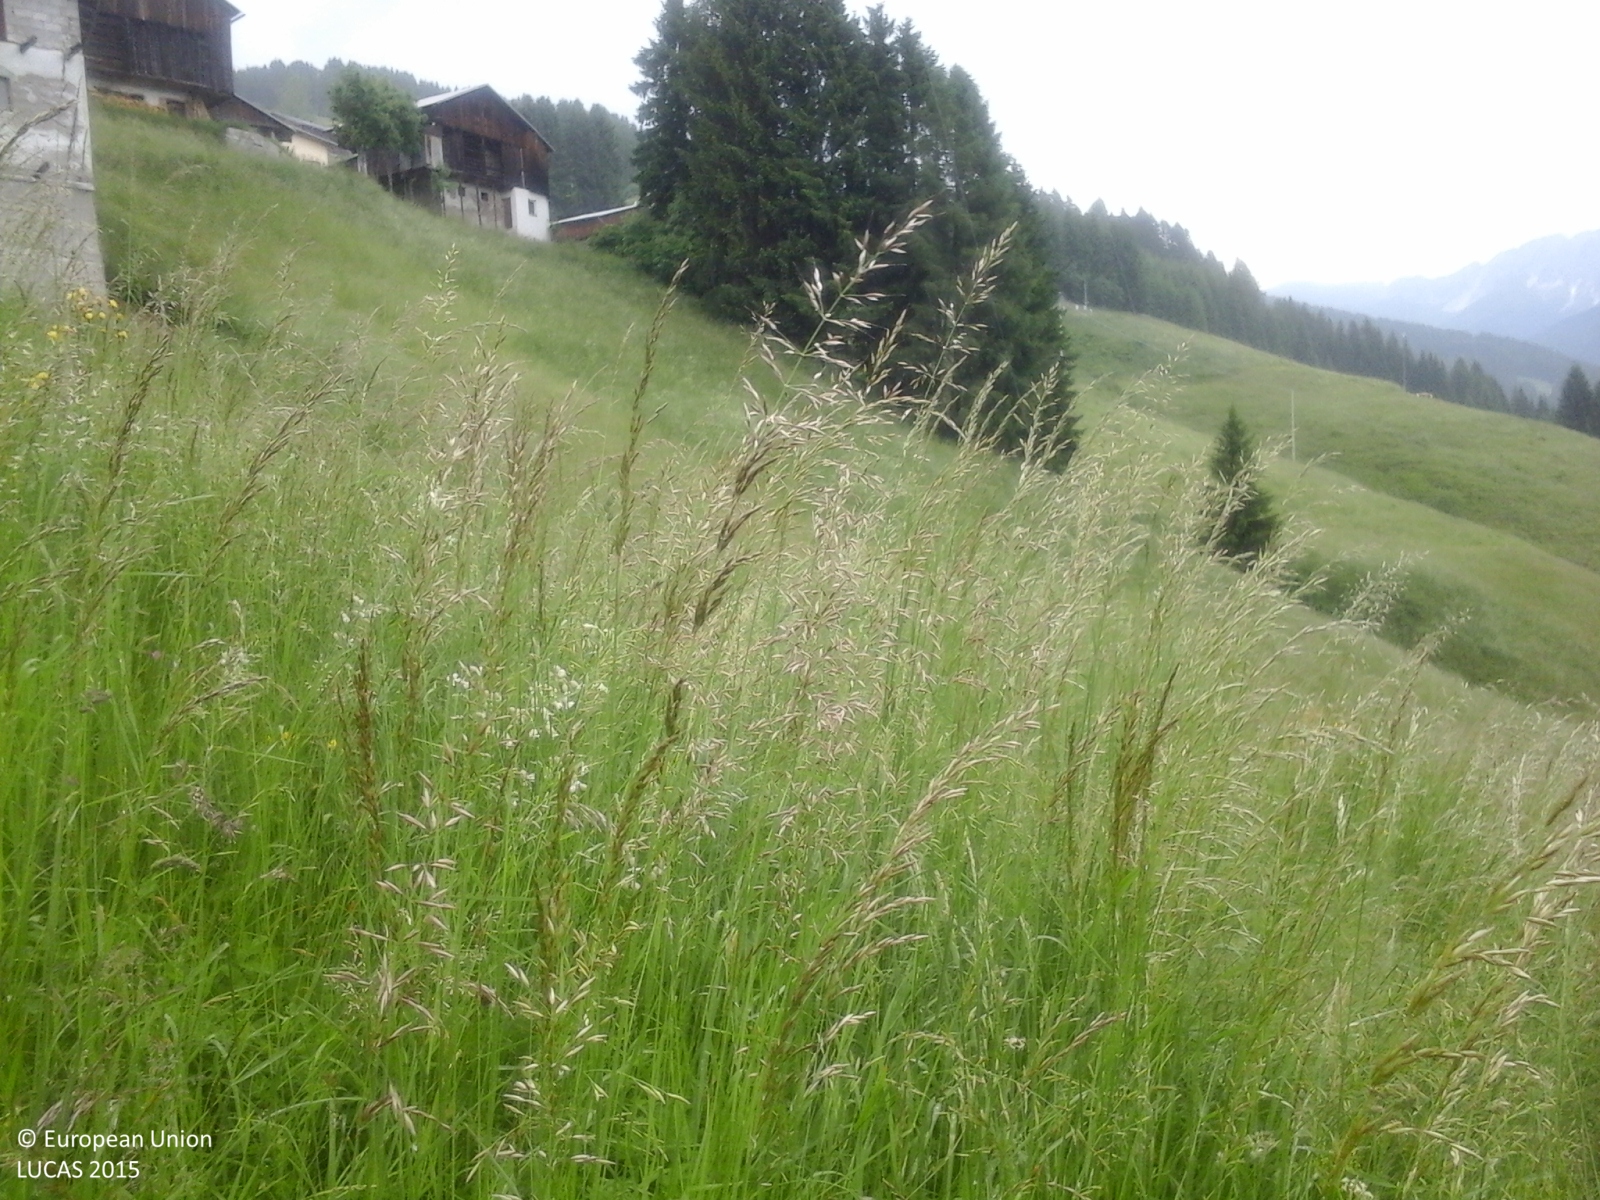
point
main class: Grassland
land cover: Grassland without tree/shrub cover
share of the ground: > 75 %
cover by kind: herbaceous plants 100 %
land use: Agriculture (excluding fallow land and kitchen gardens)
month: June
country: IT
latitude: 46.5919
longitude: 12.5165
